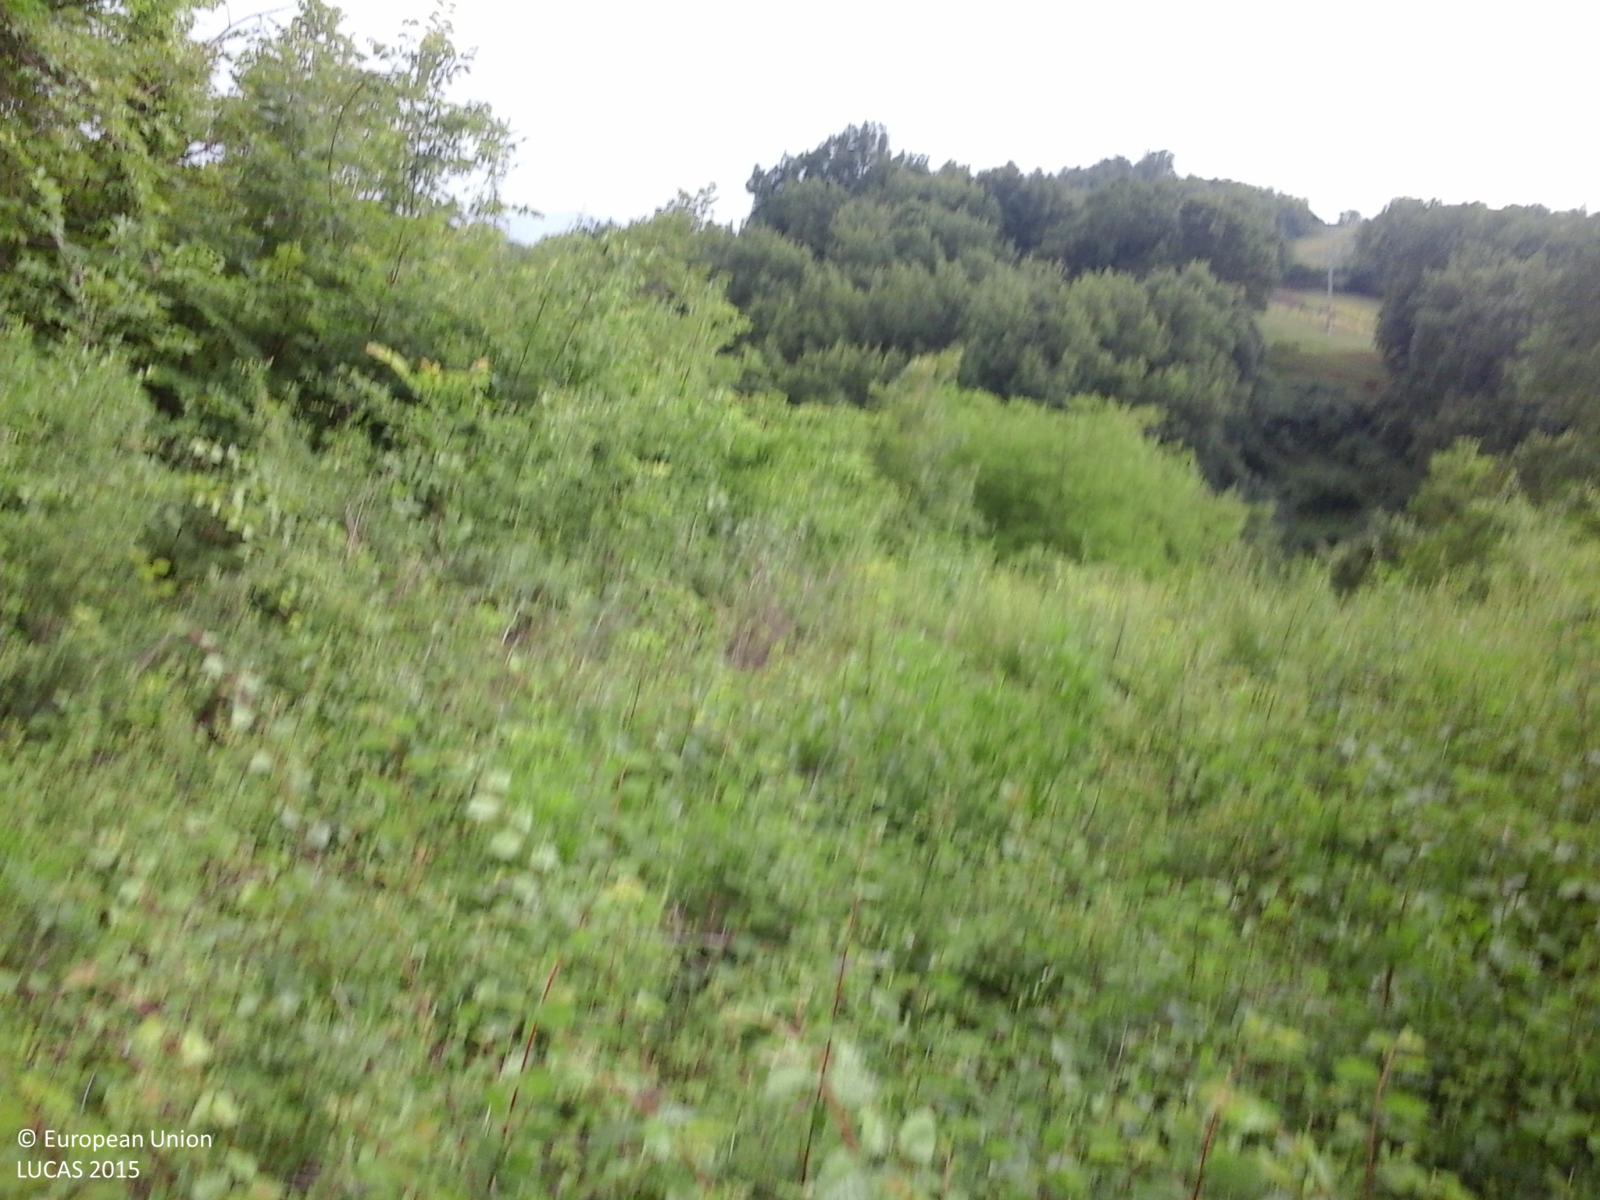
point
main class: Woodland
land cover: Broadleaved woodland
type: thermophilous deciduous forest
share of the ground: 50 - 75 %
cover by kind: broadleaved forest trees 70 %, herbaceous plants 25 %, shrubs 5 %
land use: Forestry
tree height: > 5 m
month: June
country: IT
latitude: 41.6796
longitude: 13.7703
